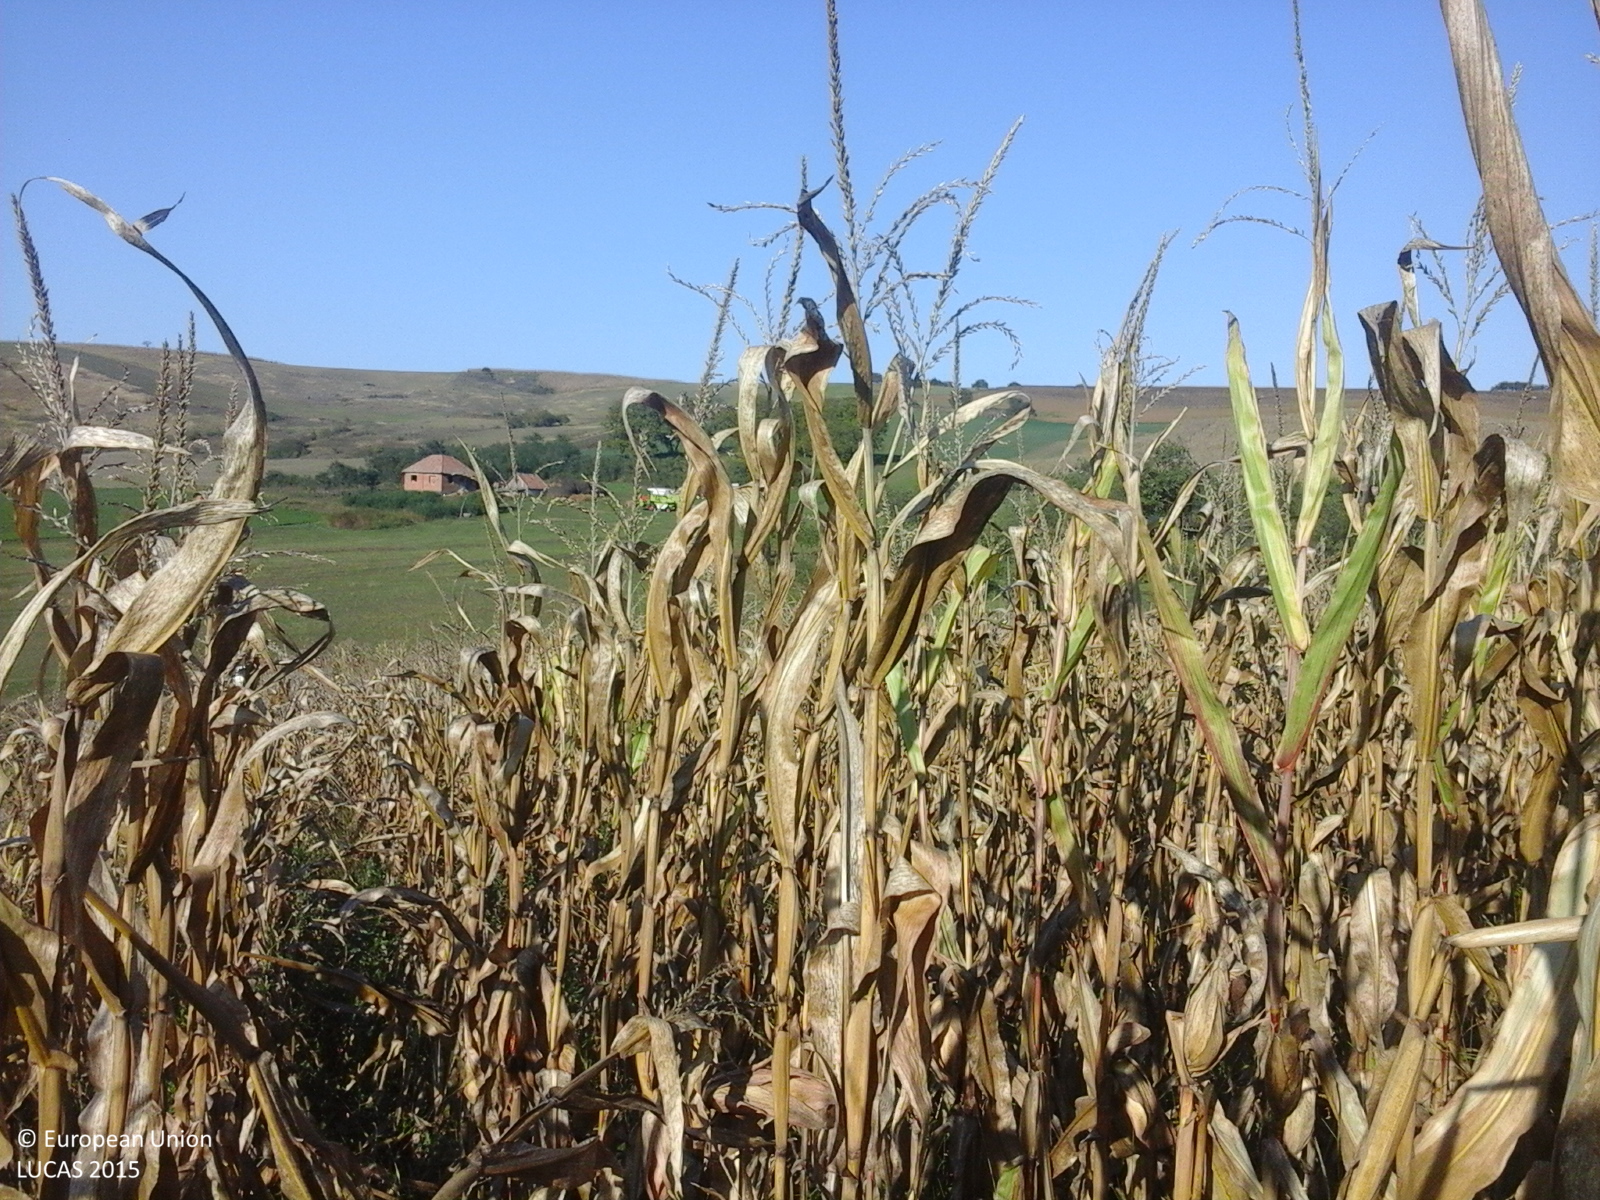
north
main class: Cropland
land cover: Maize
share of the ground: > 75 %
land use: Agriculture (excluding fallow land and kitchen gardens)
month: October
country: RO
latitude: 46.2262
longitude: 23.8809
